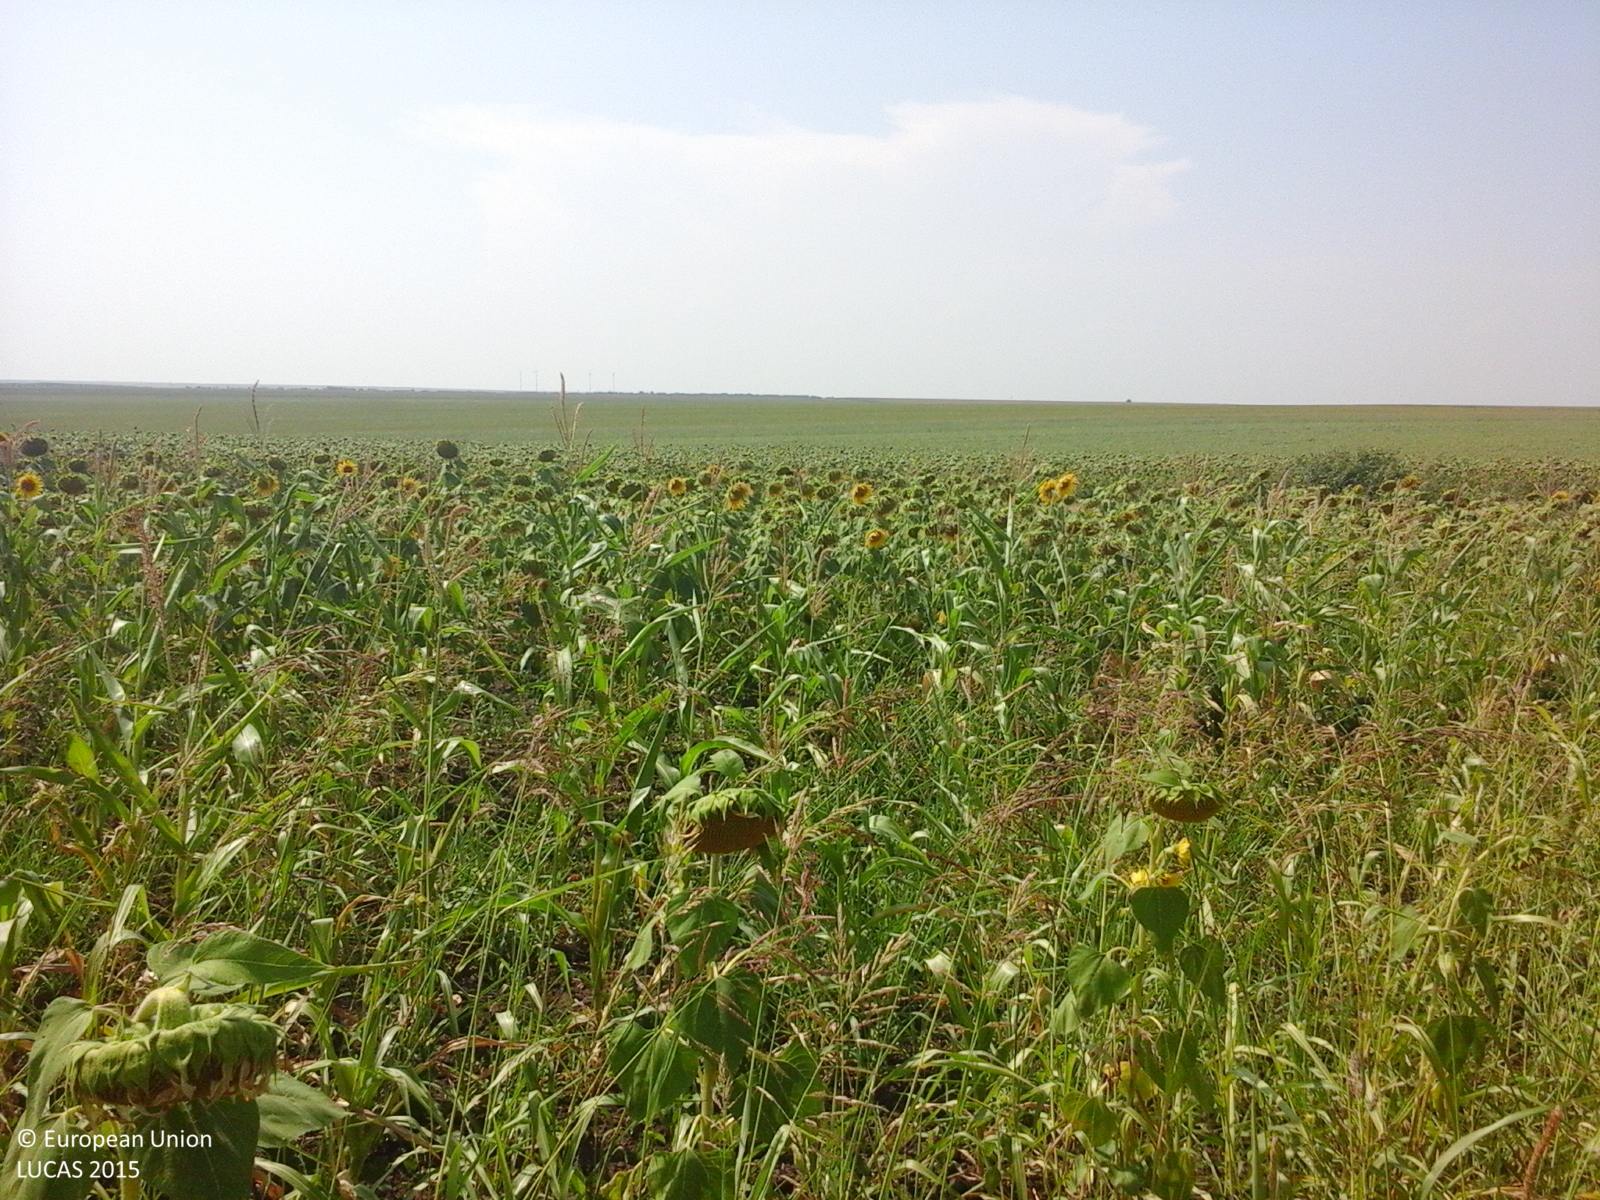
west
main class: Cropland
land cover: Sunflower
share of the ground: > 75 %
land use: Agriculture (excluding fallow land and kitchen gardens)
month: July
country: RO
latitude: 45.6259
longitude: 27.8529
